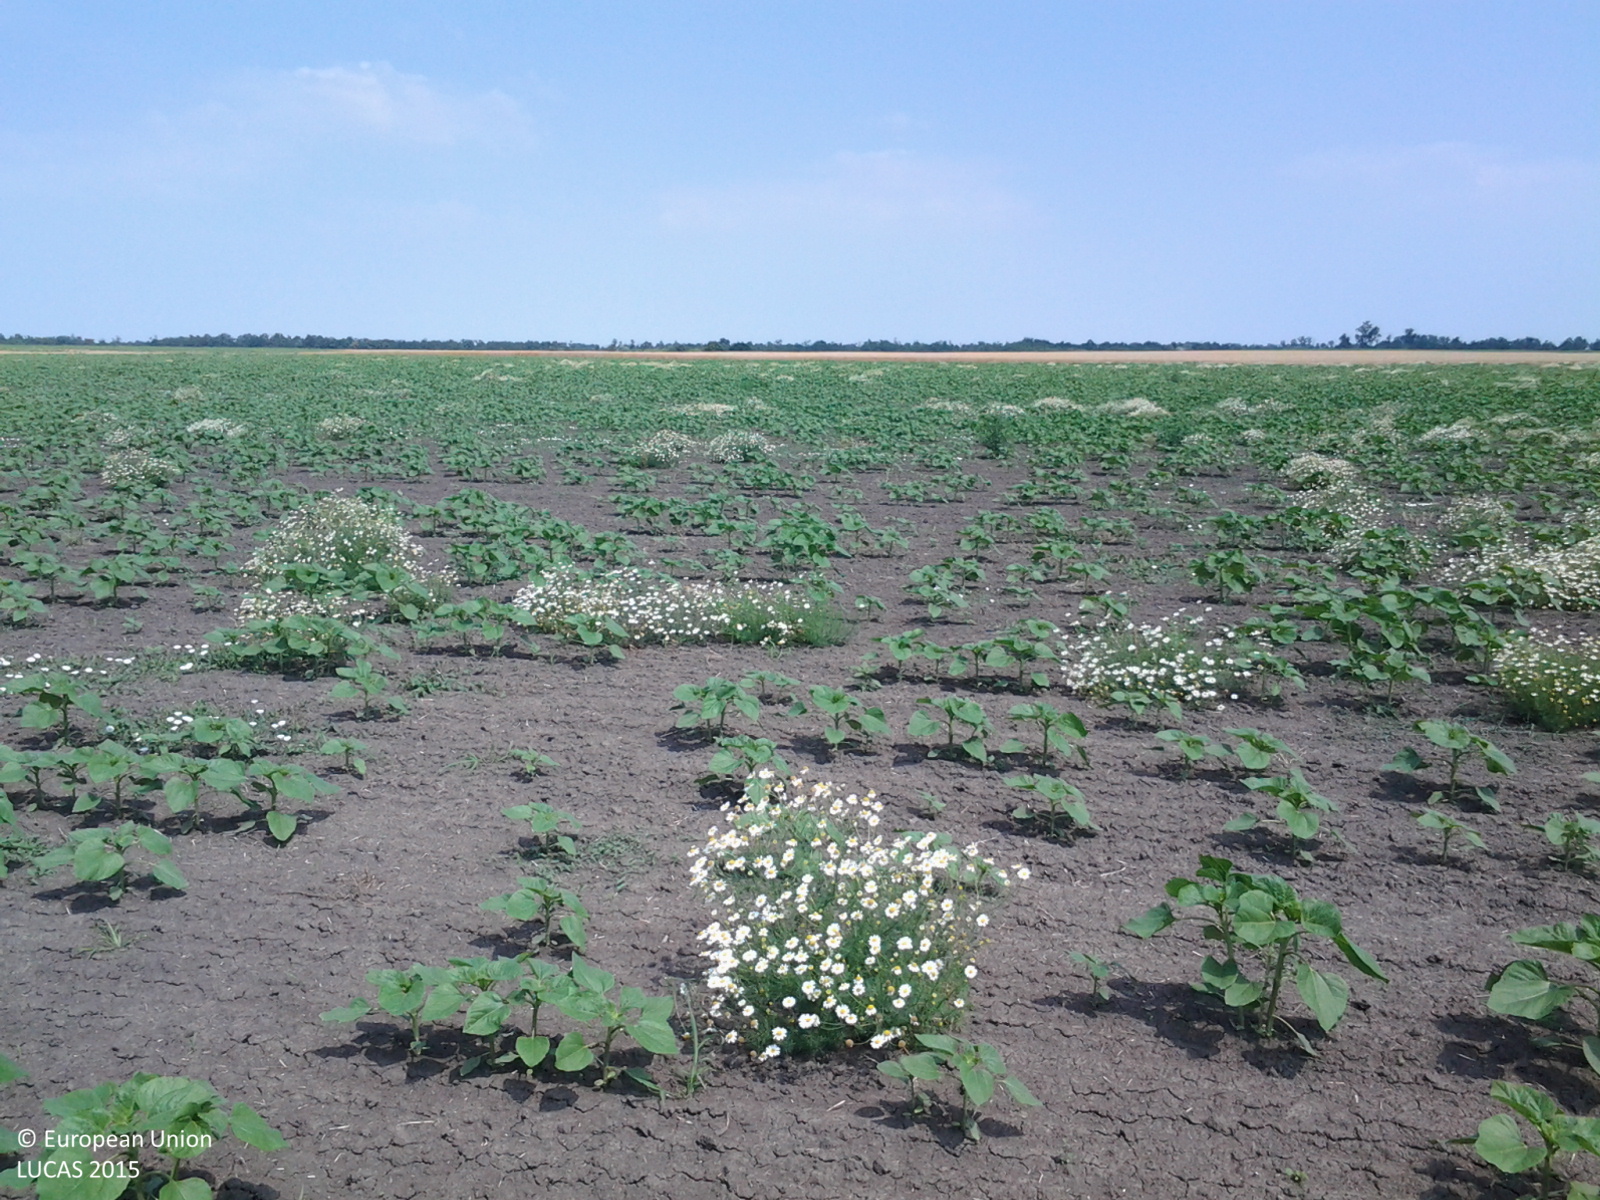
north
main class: Cropland
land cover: Sunflower
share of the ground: 25 - 50 %
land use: Agriculture (excluding fallow land and kitchen gardens)
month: July
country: HU
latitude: 46.9761
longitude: 20.5056
